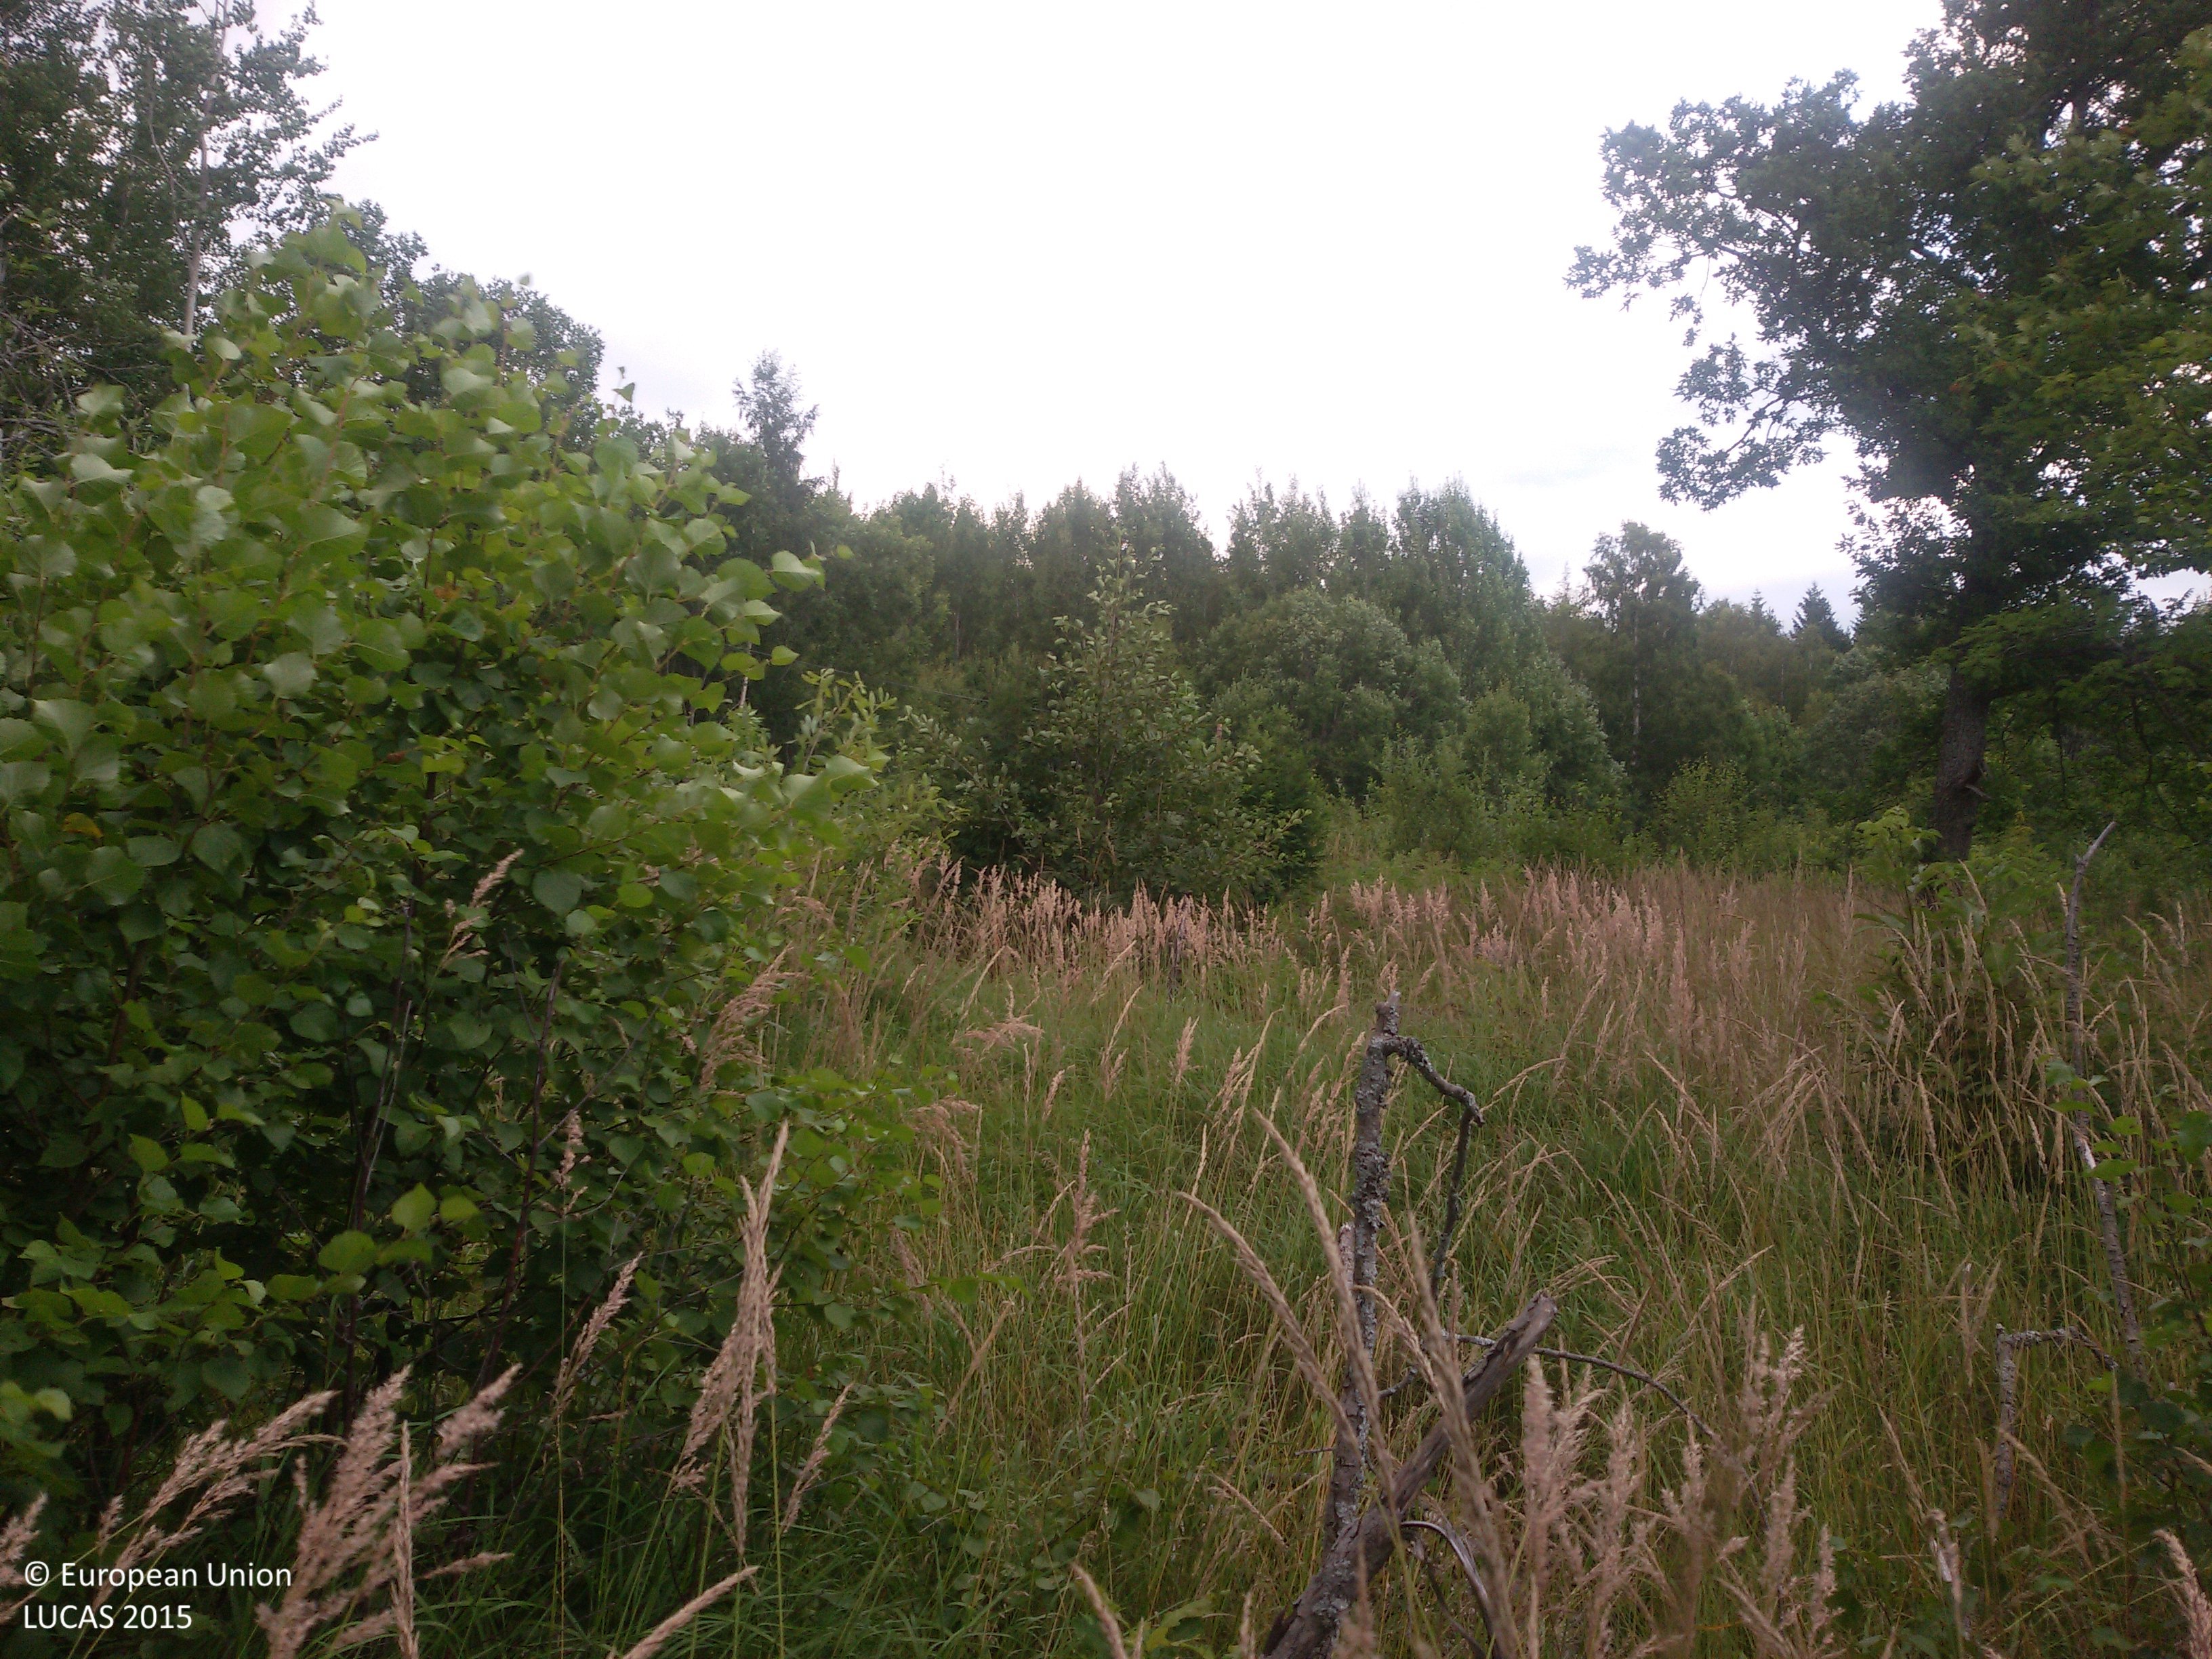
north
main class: Woodland
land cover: Broadleaved woodland
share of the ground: 25 - 50 %
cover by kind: herbaceous plants 50 %, broadleaved forest trees 30 %, shrubs 20 %
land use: Semi-natural and natural areas not in use
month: August
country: SE
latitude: 60.5337
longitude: 16.5675
